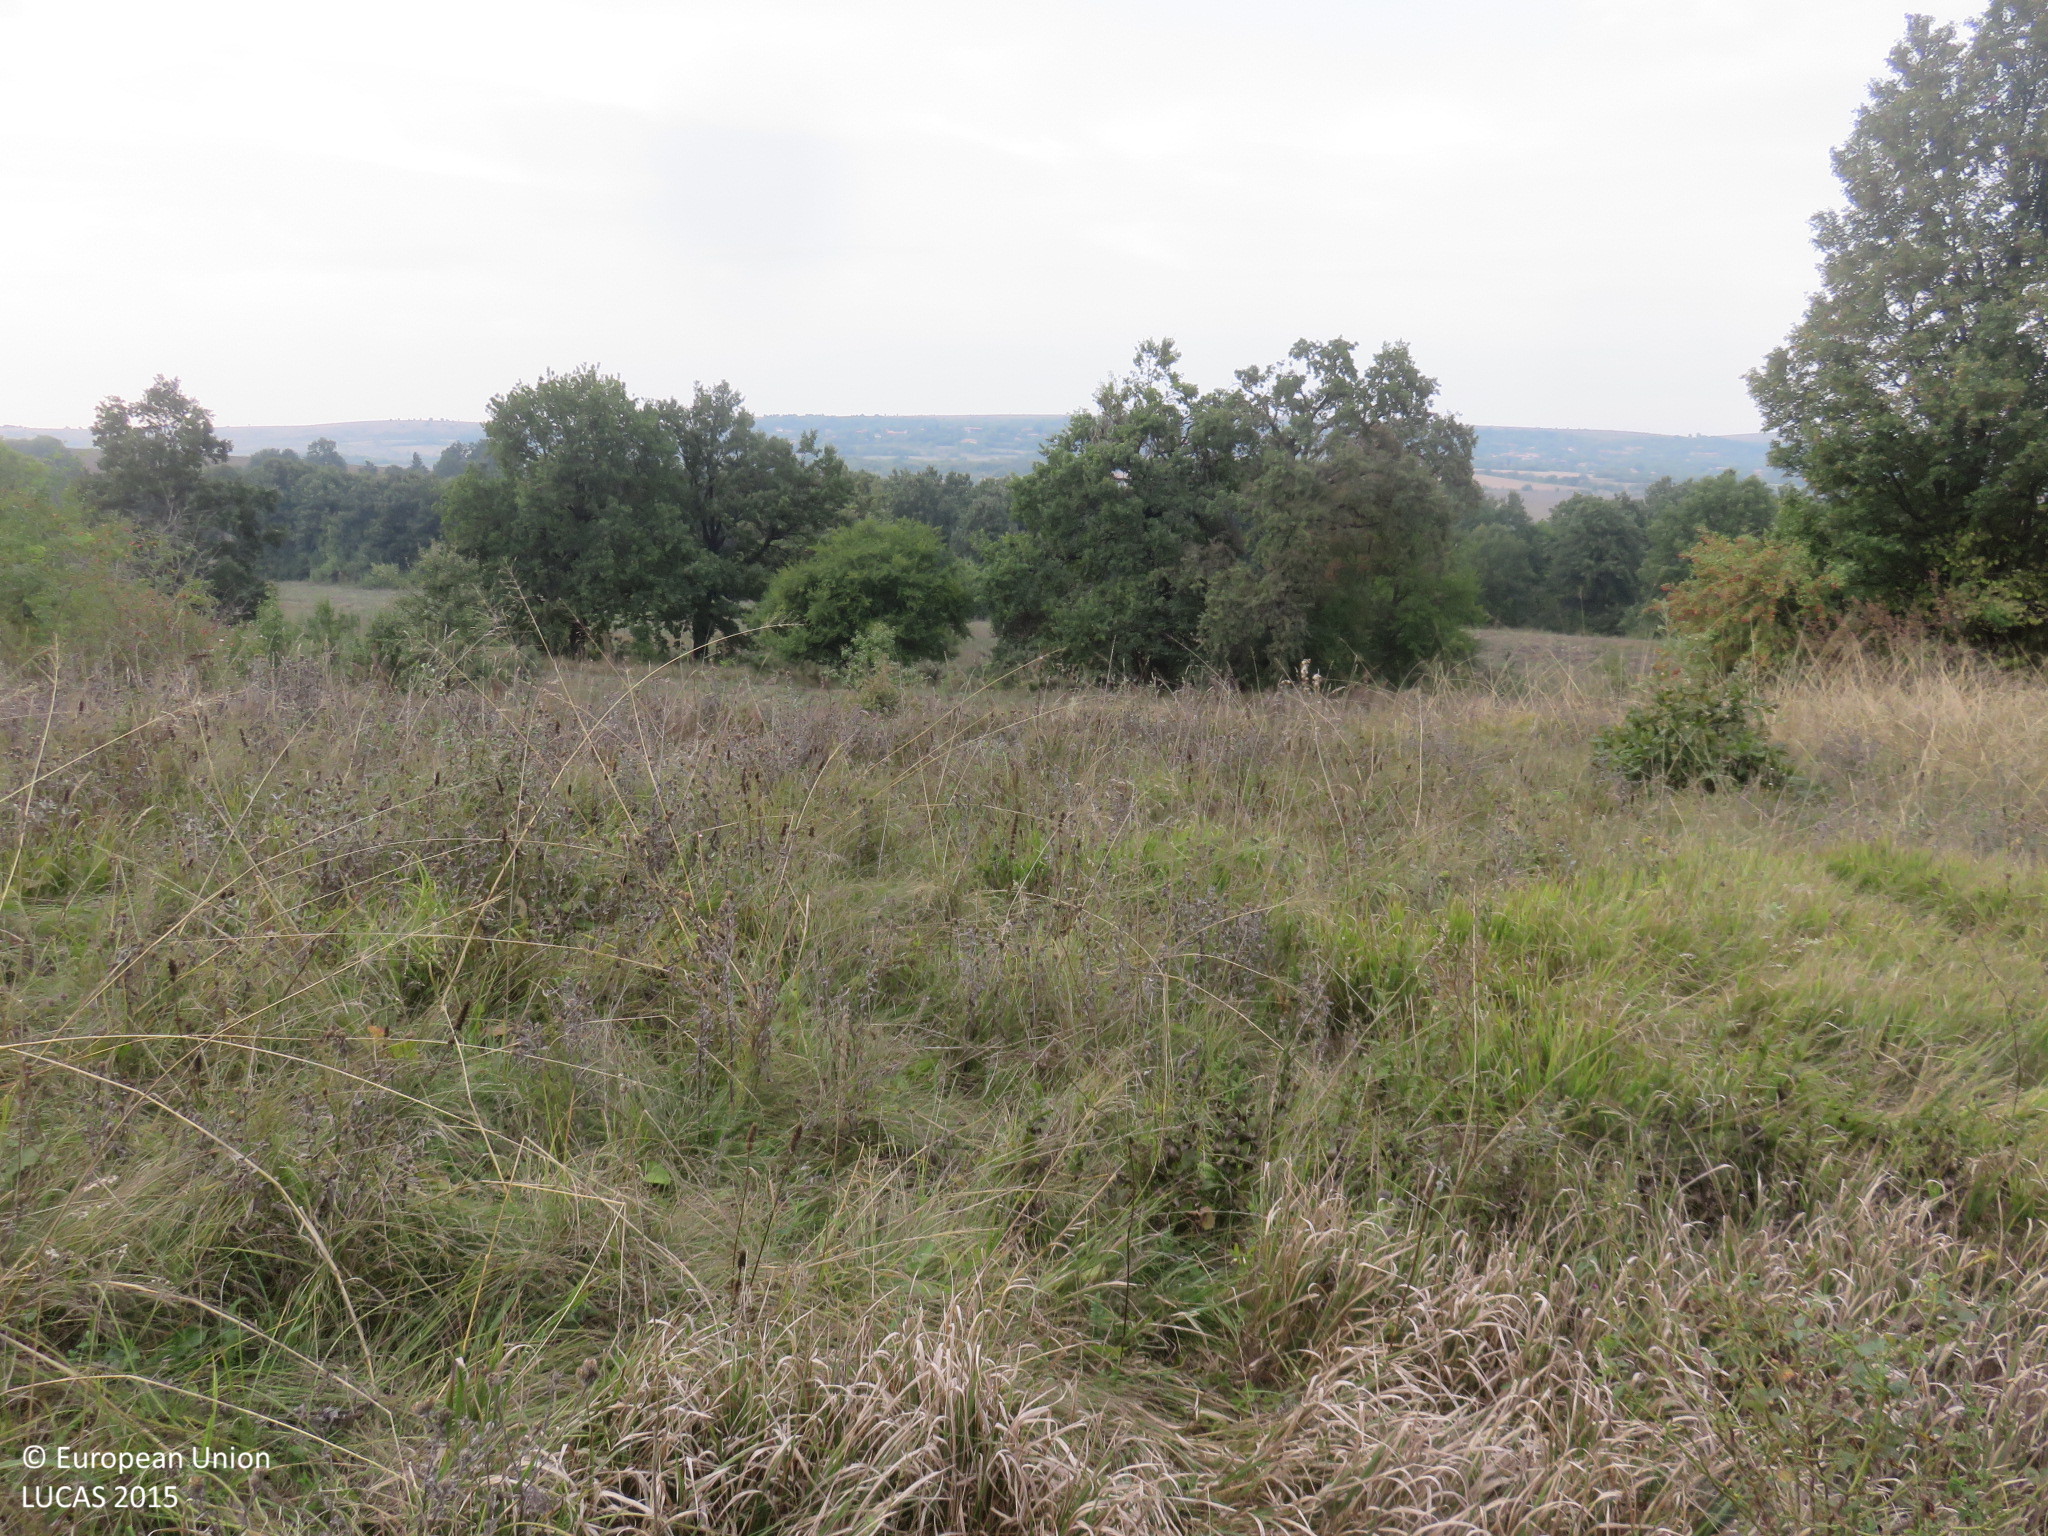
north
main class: Grassland
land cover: Grassland with sparse tree/shrub cover
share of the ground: > 75 %
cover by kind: herbaceous plants 95 %, broadleaved forest trees 5 %
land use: Semi-natural and natural areas not in use
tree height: > 5 m
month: September
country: BG
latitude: 43.1175
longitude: 24.9245
